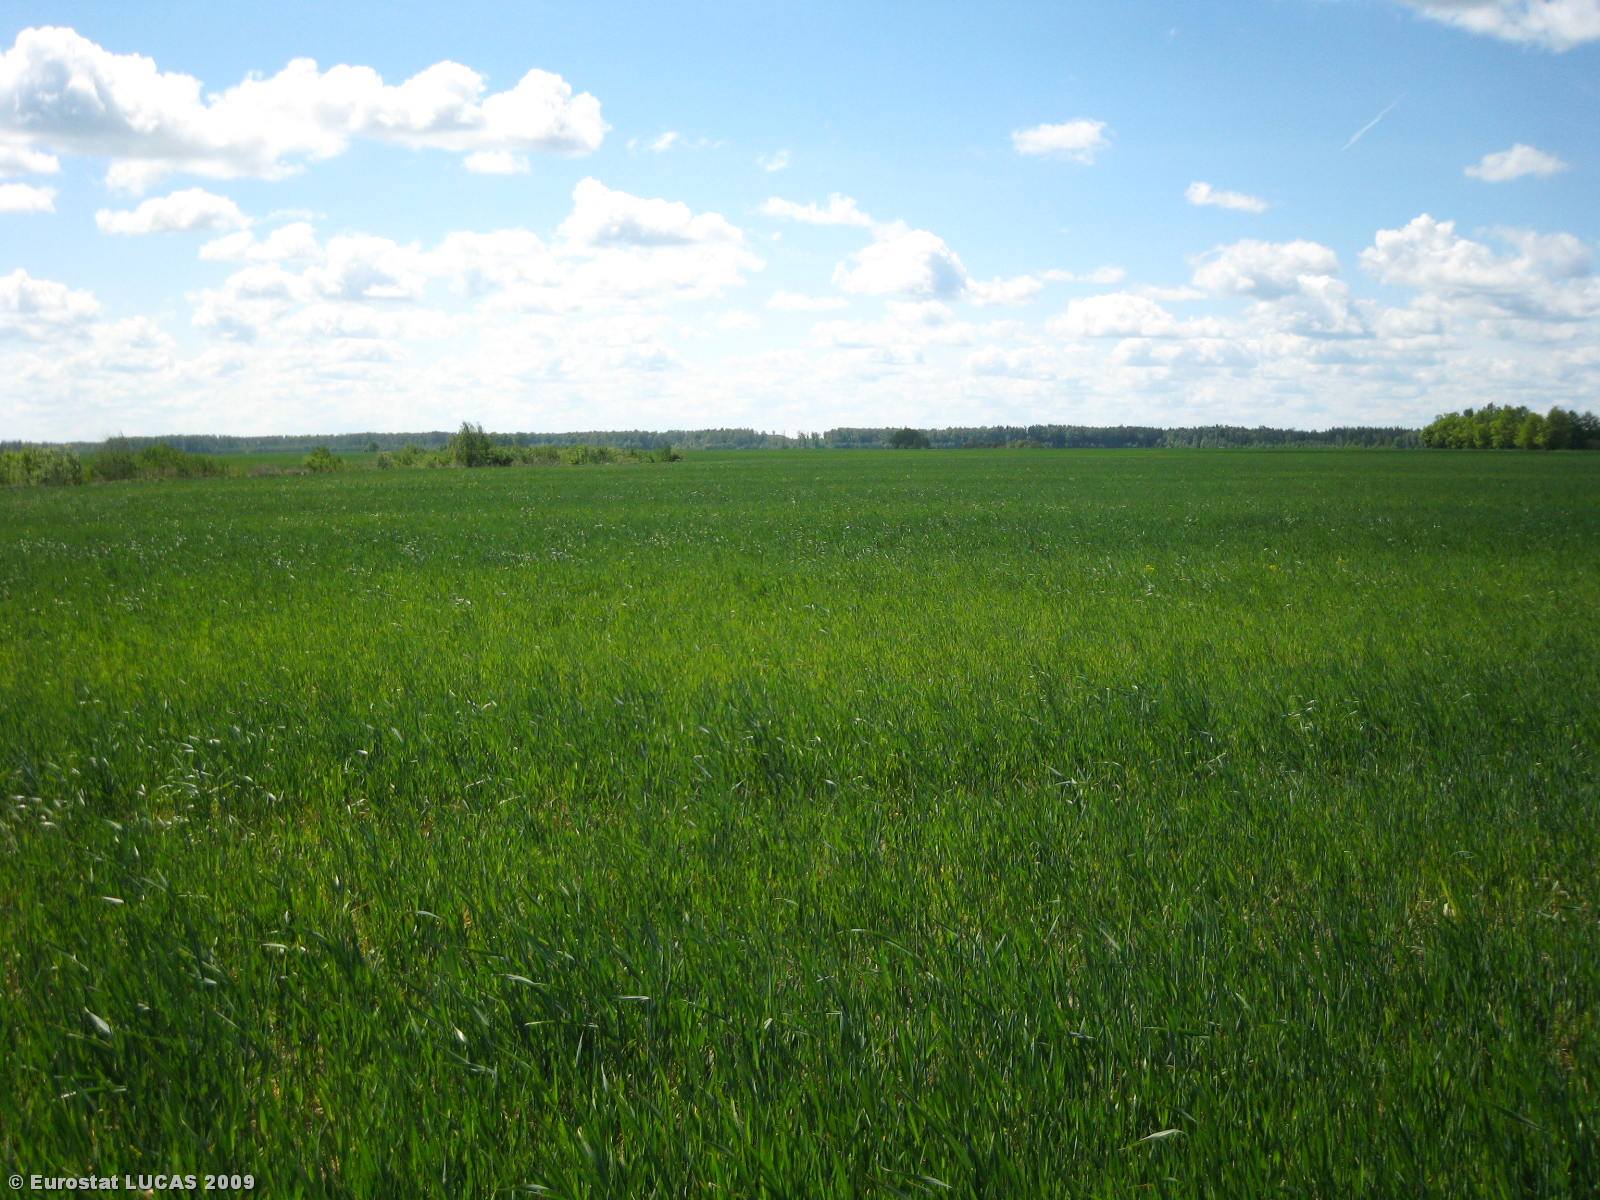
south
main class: Cropland
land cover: Common wheat
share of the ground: > 75 %
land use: Agriculture (excluding fallow land and kitchen gardens)
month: May
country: LT
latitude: 56.0469
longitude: 24.0718
